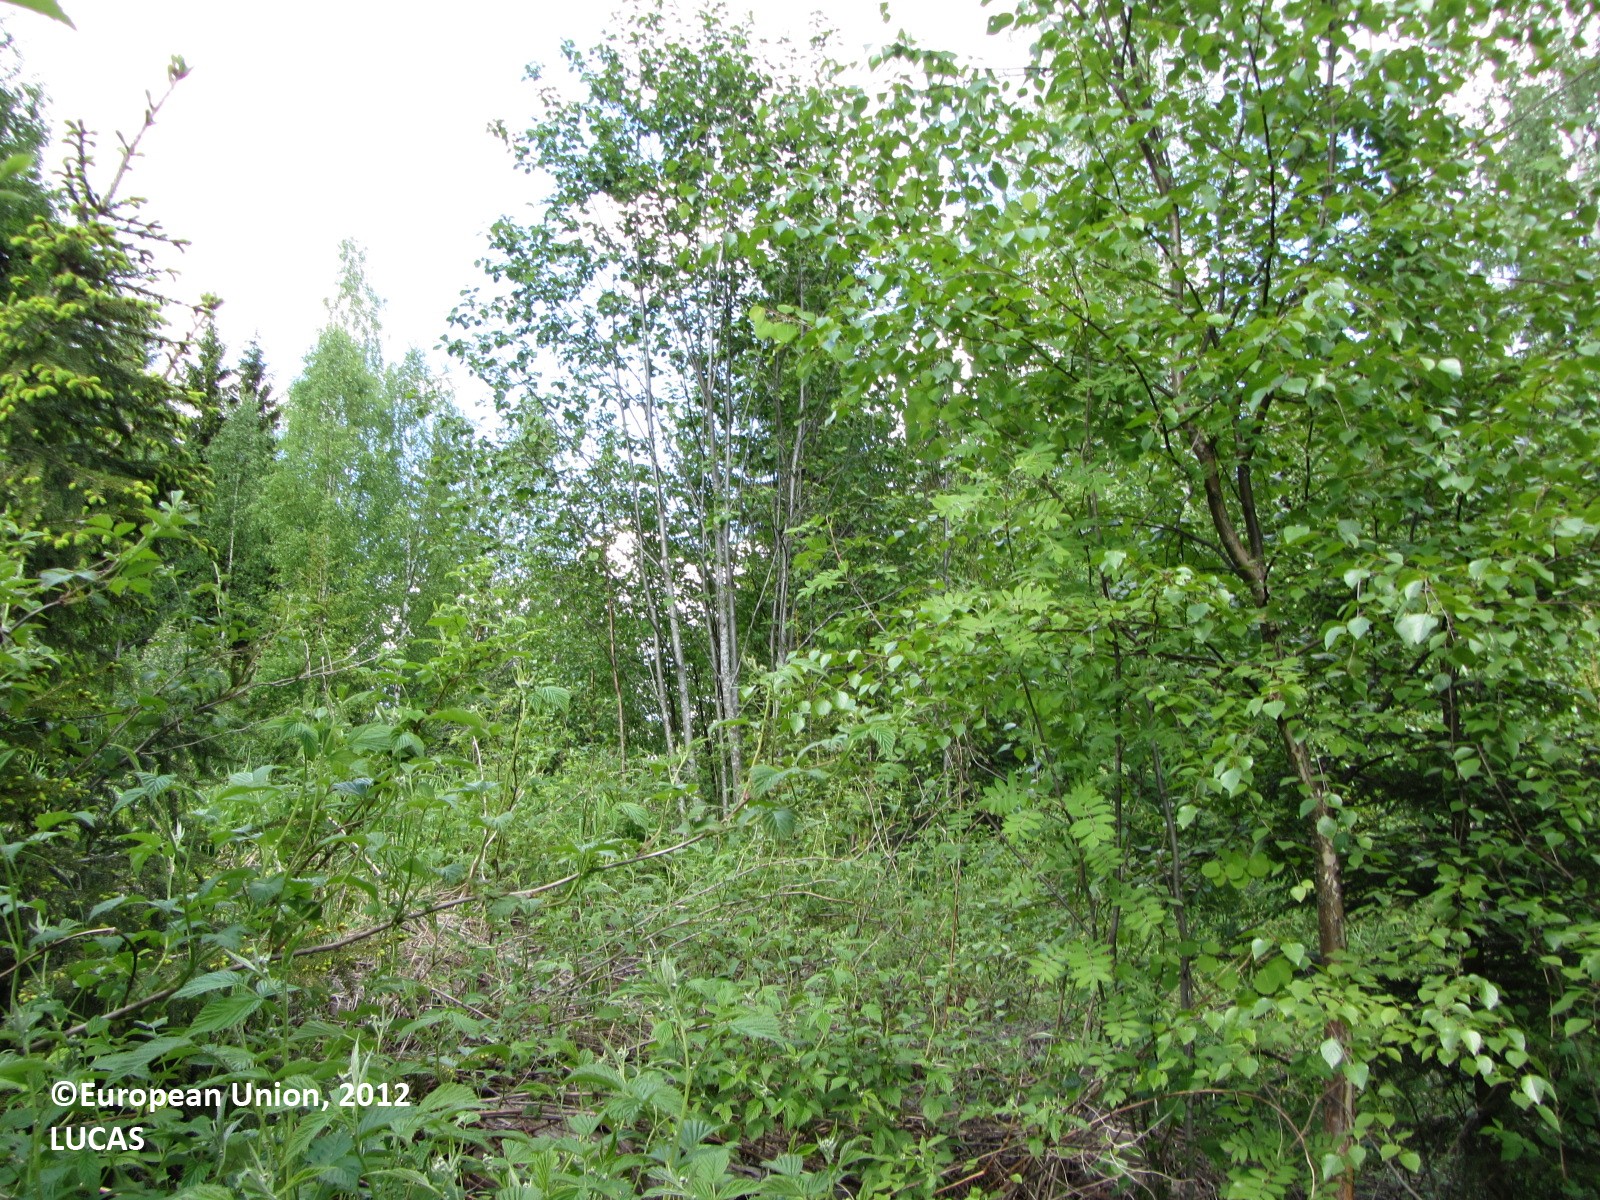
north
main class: Woodland
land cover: Spruce dominated mixed woodland
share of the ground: > 75 %
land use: Forestry
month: June
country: FI
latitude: 61.8057
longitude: 25.1171
